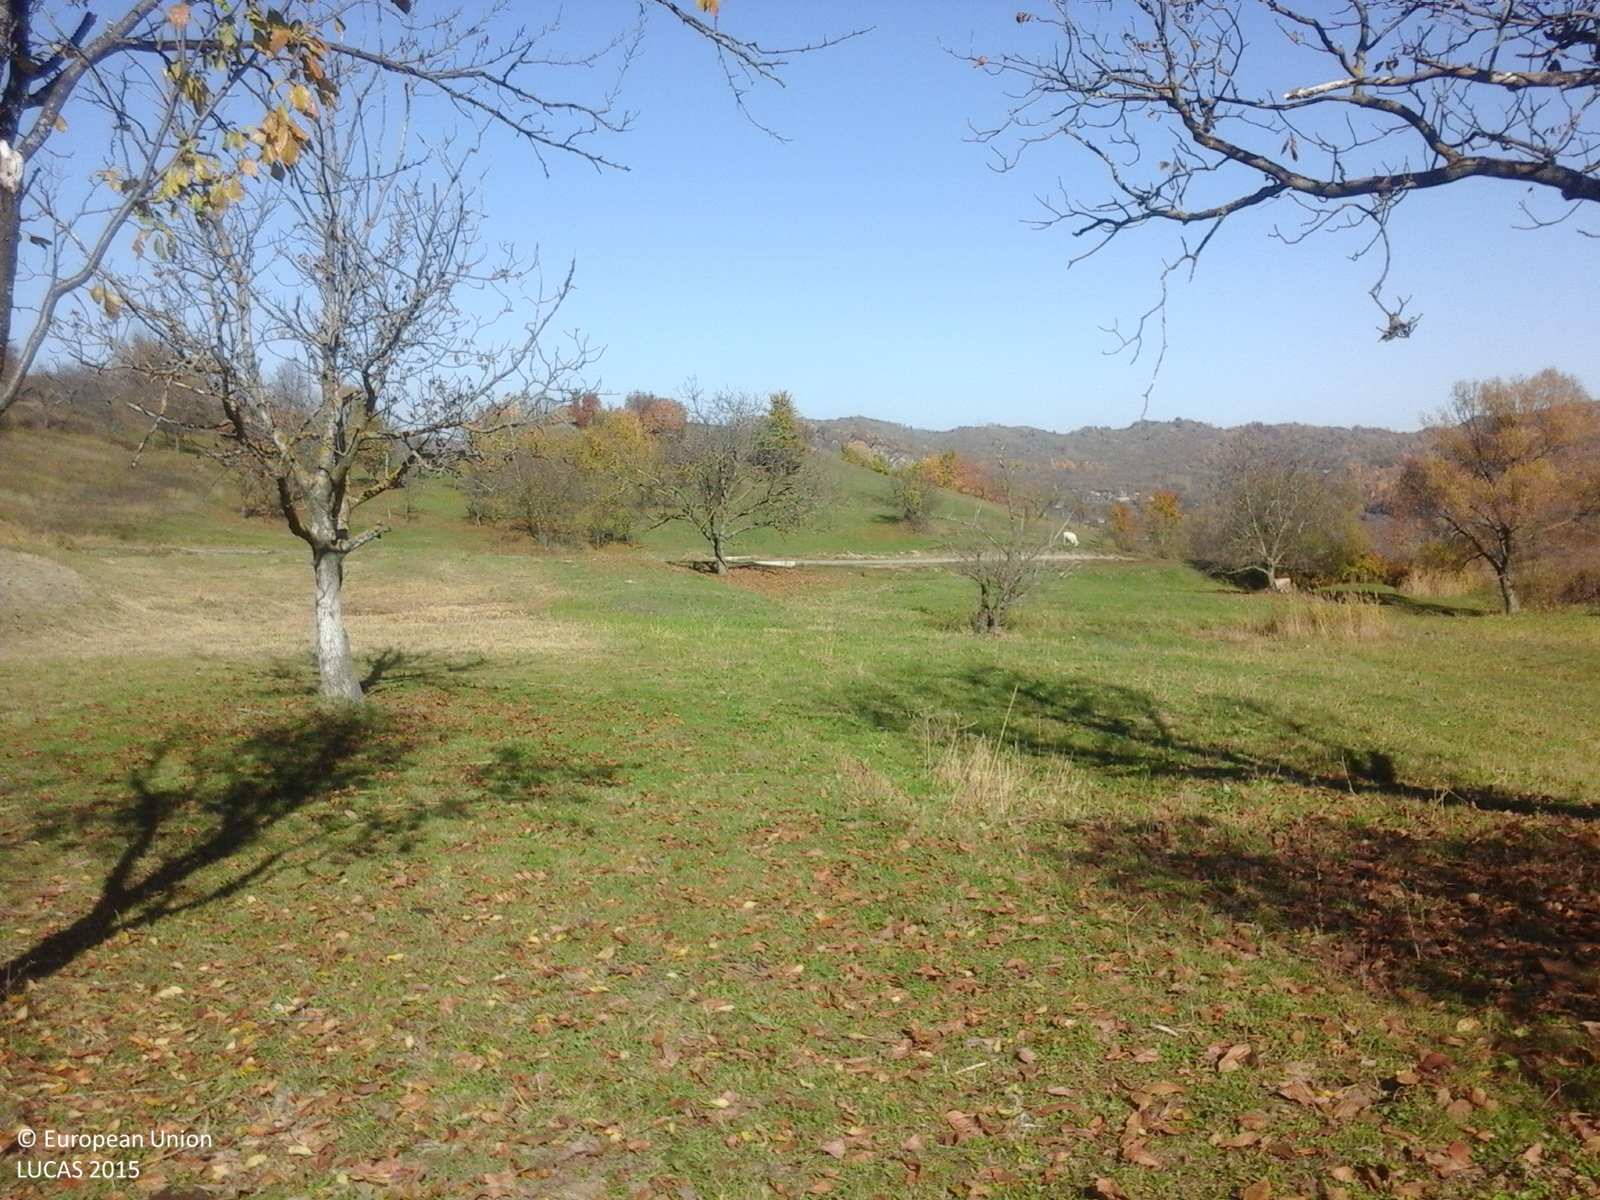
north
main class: Cropland
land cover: Other fruit trees and berries
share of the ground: 25 - 50 %
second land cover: Grassland without tree/shrub cover
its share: > 75 %
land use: Agriculture (excluding fallow land and kitchen gardens)
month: October
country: RO
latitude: 45.4833
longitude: 26.8302
